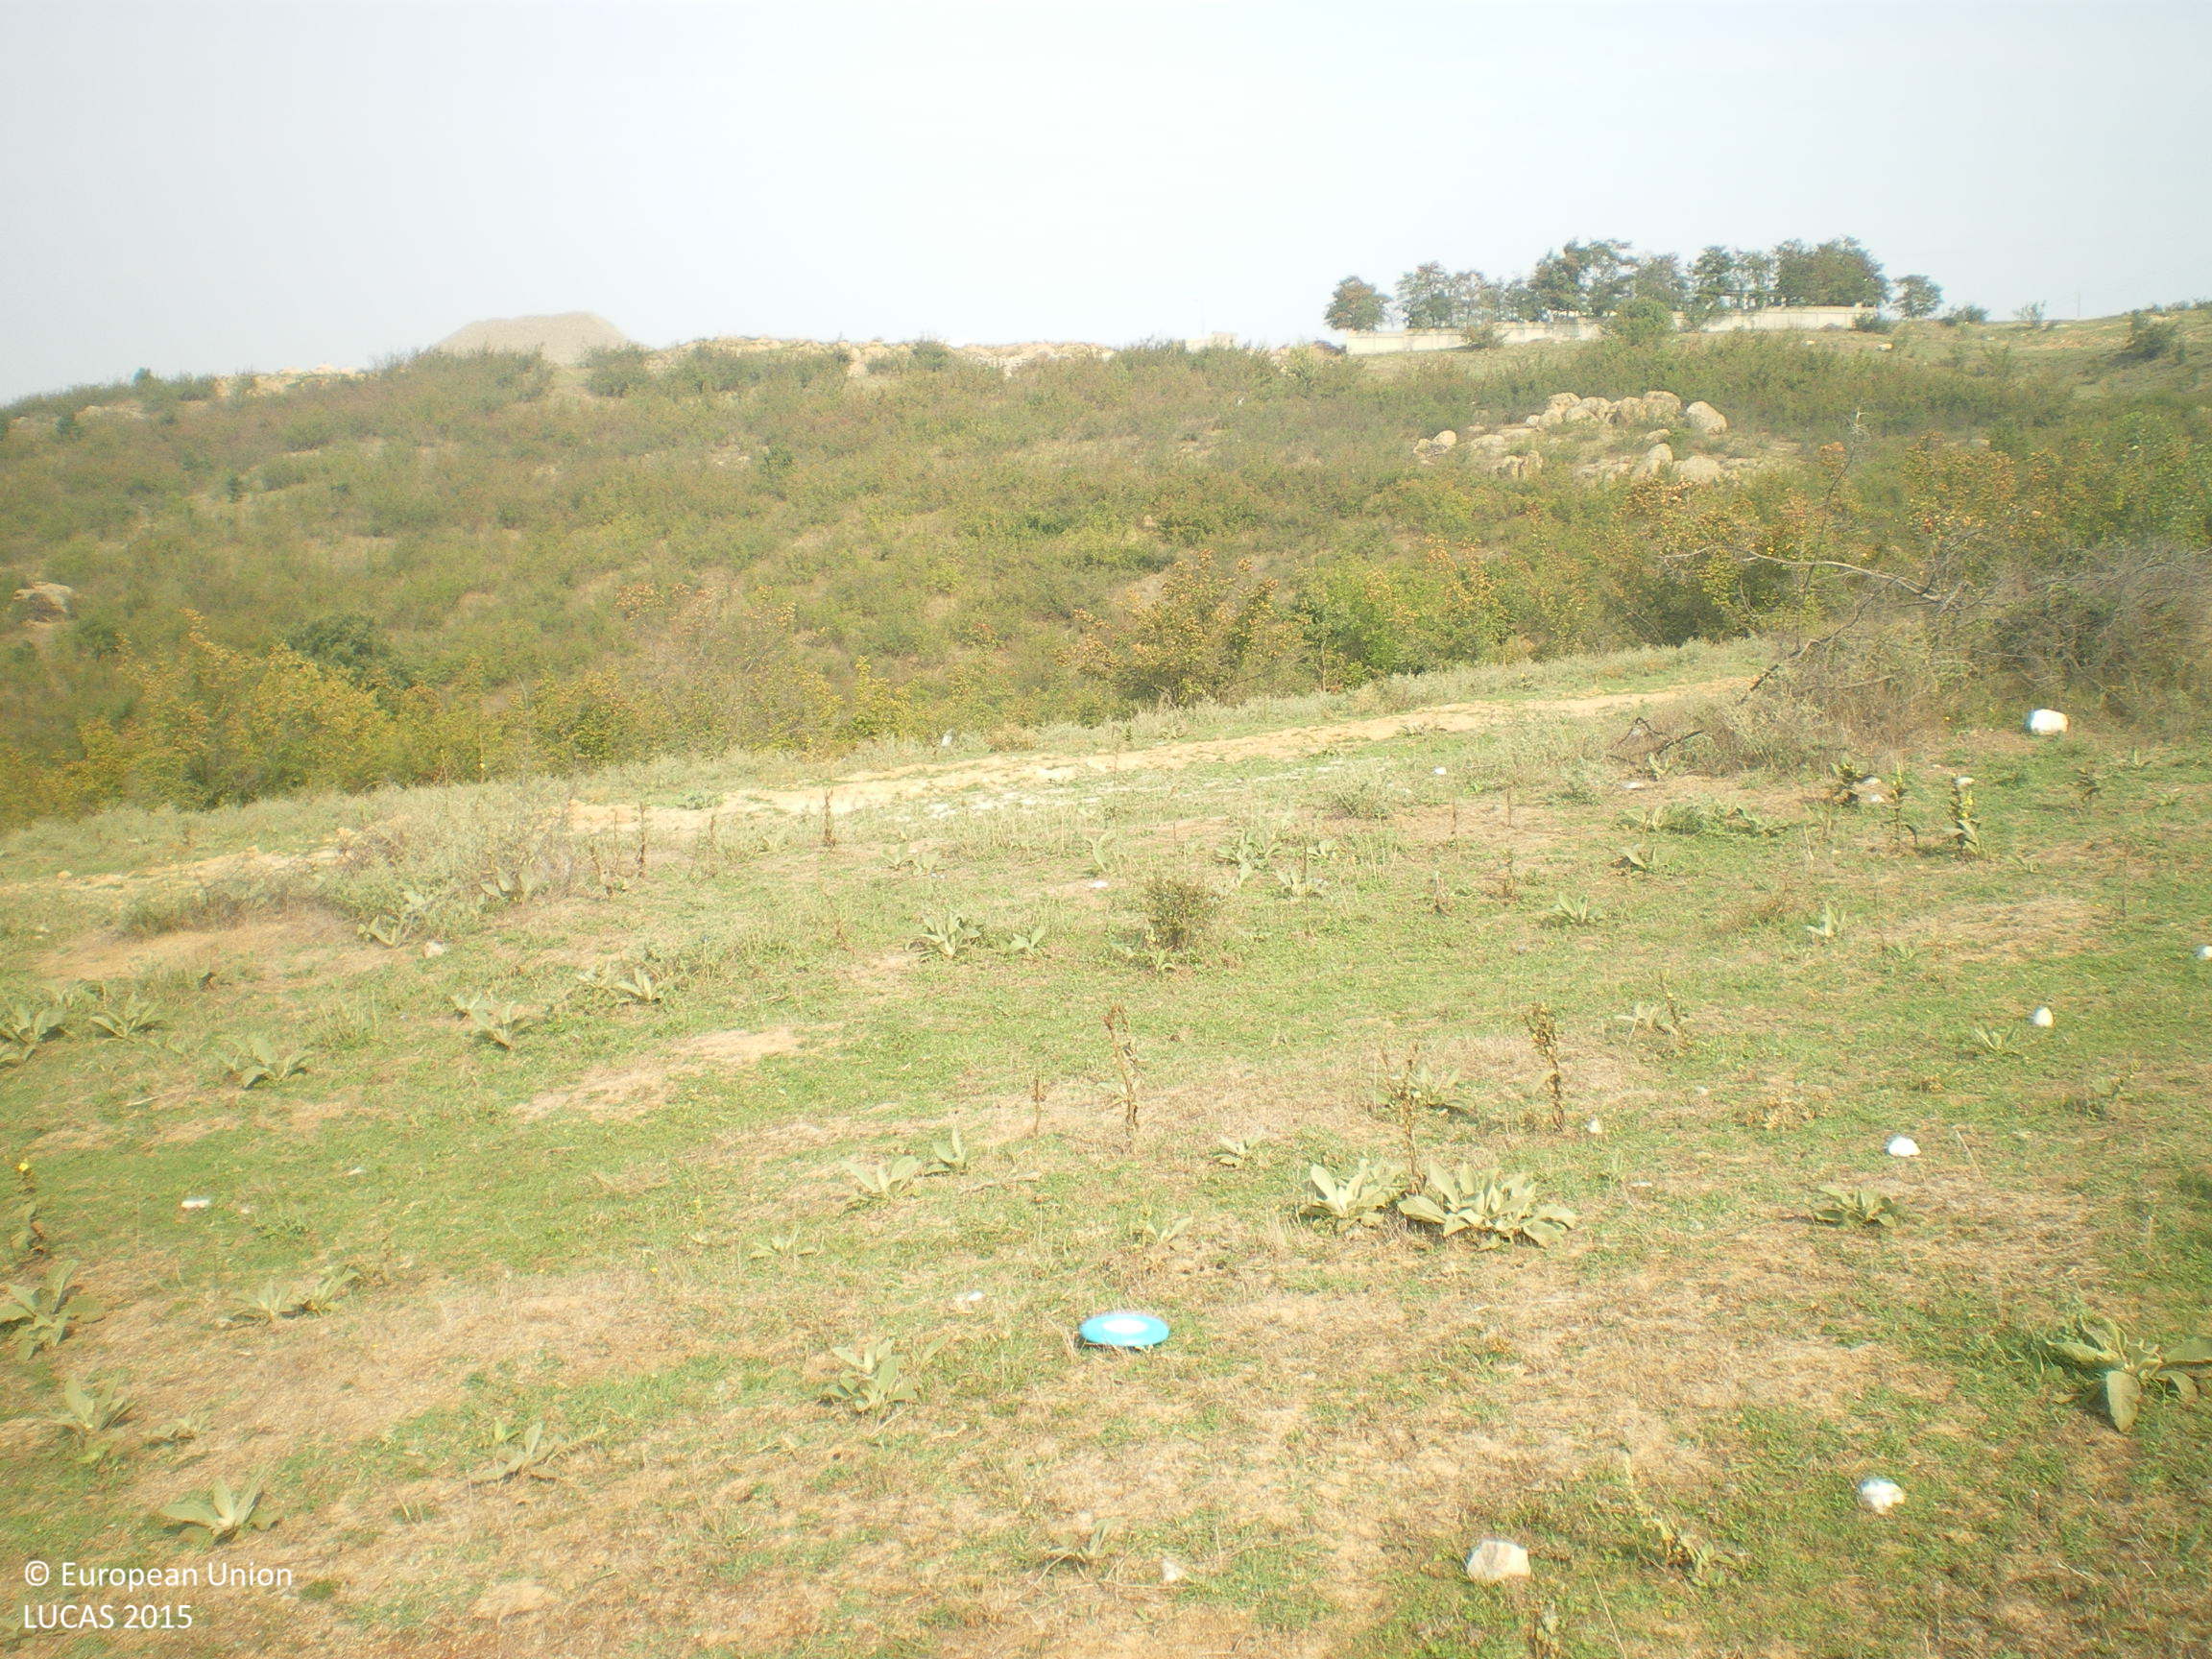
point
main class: Grassland
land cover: Grassland without tree/shrub cover
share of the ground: > 75 %
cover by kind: herbaceous plants 100 %
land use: Agriculture (excluding fallow land and kitchen gardens)
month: September
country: BG
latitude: 41.9033
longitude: 25.8986
